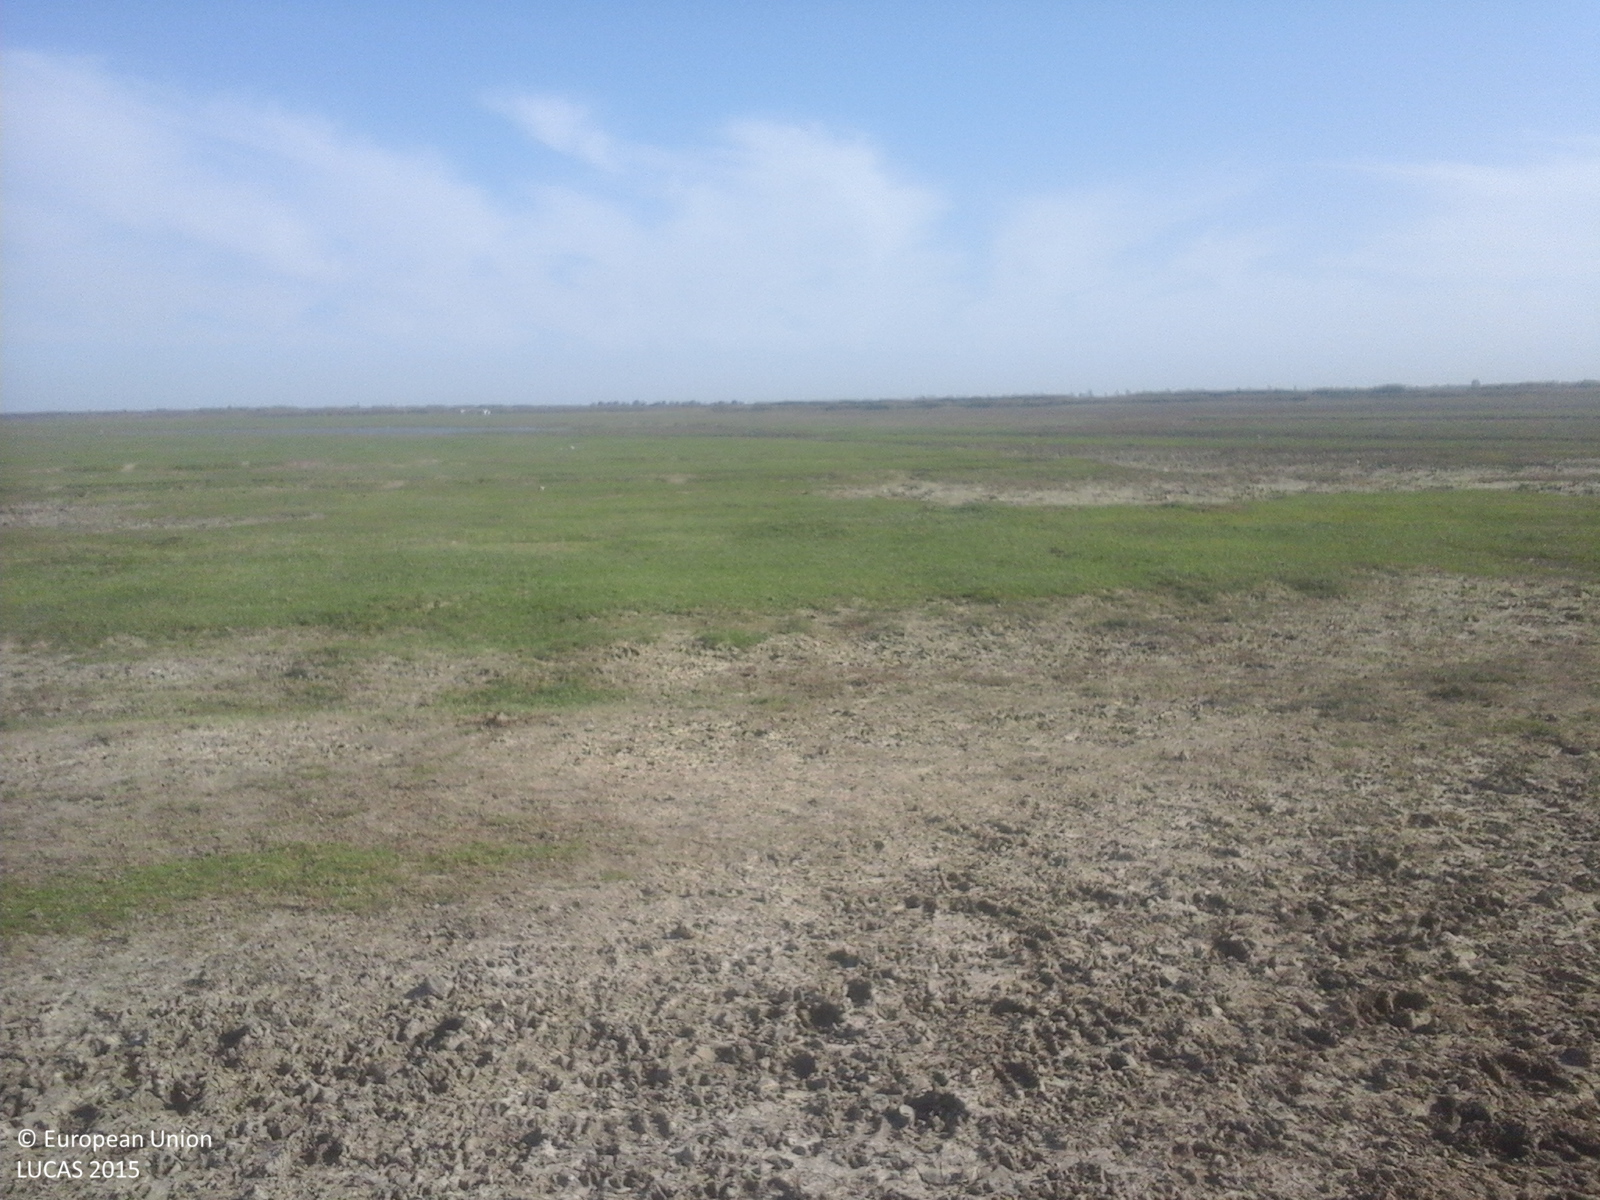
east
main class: Grassland
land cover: Grassland without tree/shrub cover
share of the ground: > 75 %
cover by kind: herbaceous plants 100 %
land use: Agriculture (excluding fallow land and kitchen gardens)
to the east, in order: Grassland without tree/shrub cover
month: October
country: RO
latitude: 45.2839
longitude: 27.3714
